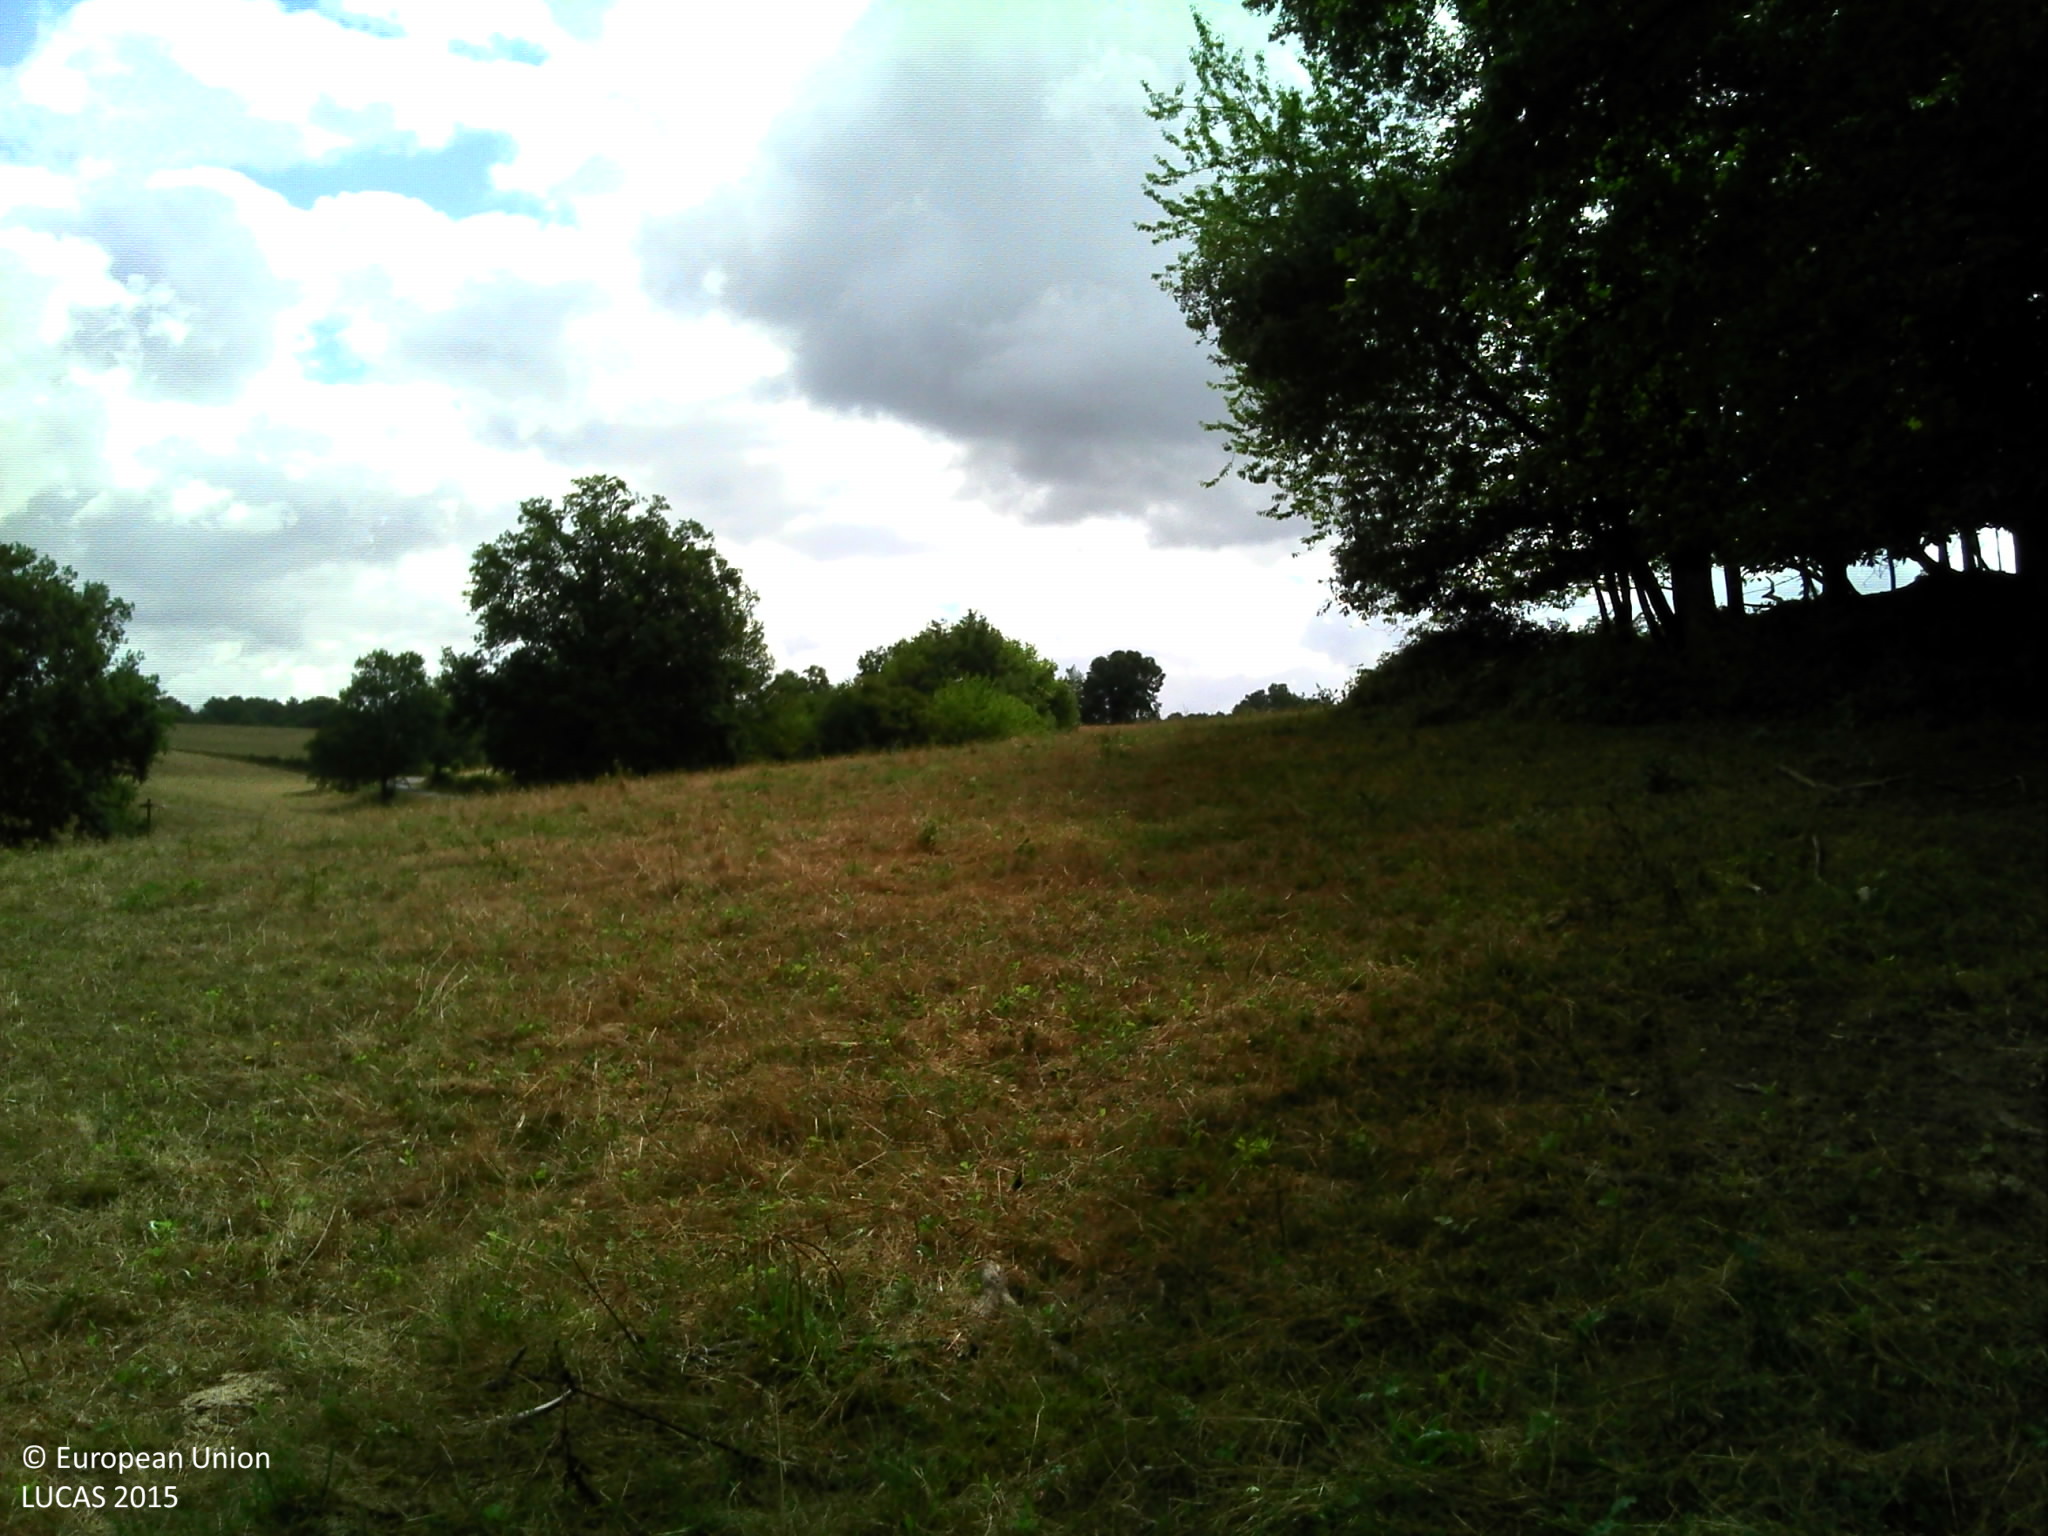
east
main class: Grassland
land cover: Grassland without tree/shrub cover
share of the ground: > 75 %
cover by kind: herbaceous plants 95 %, lichens and mosses 5 %
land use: Agriculture (excluding fallow land and kitchen gardens)
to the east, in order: Grassland without tree/shrub cover; Lines of trees; Fences; Paved roads, cycling and walking lanes; Electric lines; Fences; Grassland without tree/shrub cover; Fences; Electric lines; Paved roads, cycling and walking lanes; Fences; Grassland without tree/shrub cover
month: July
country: FR
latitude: 45.0217
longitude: 0.9185
